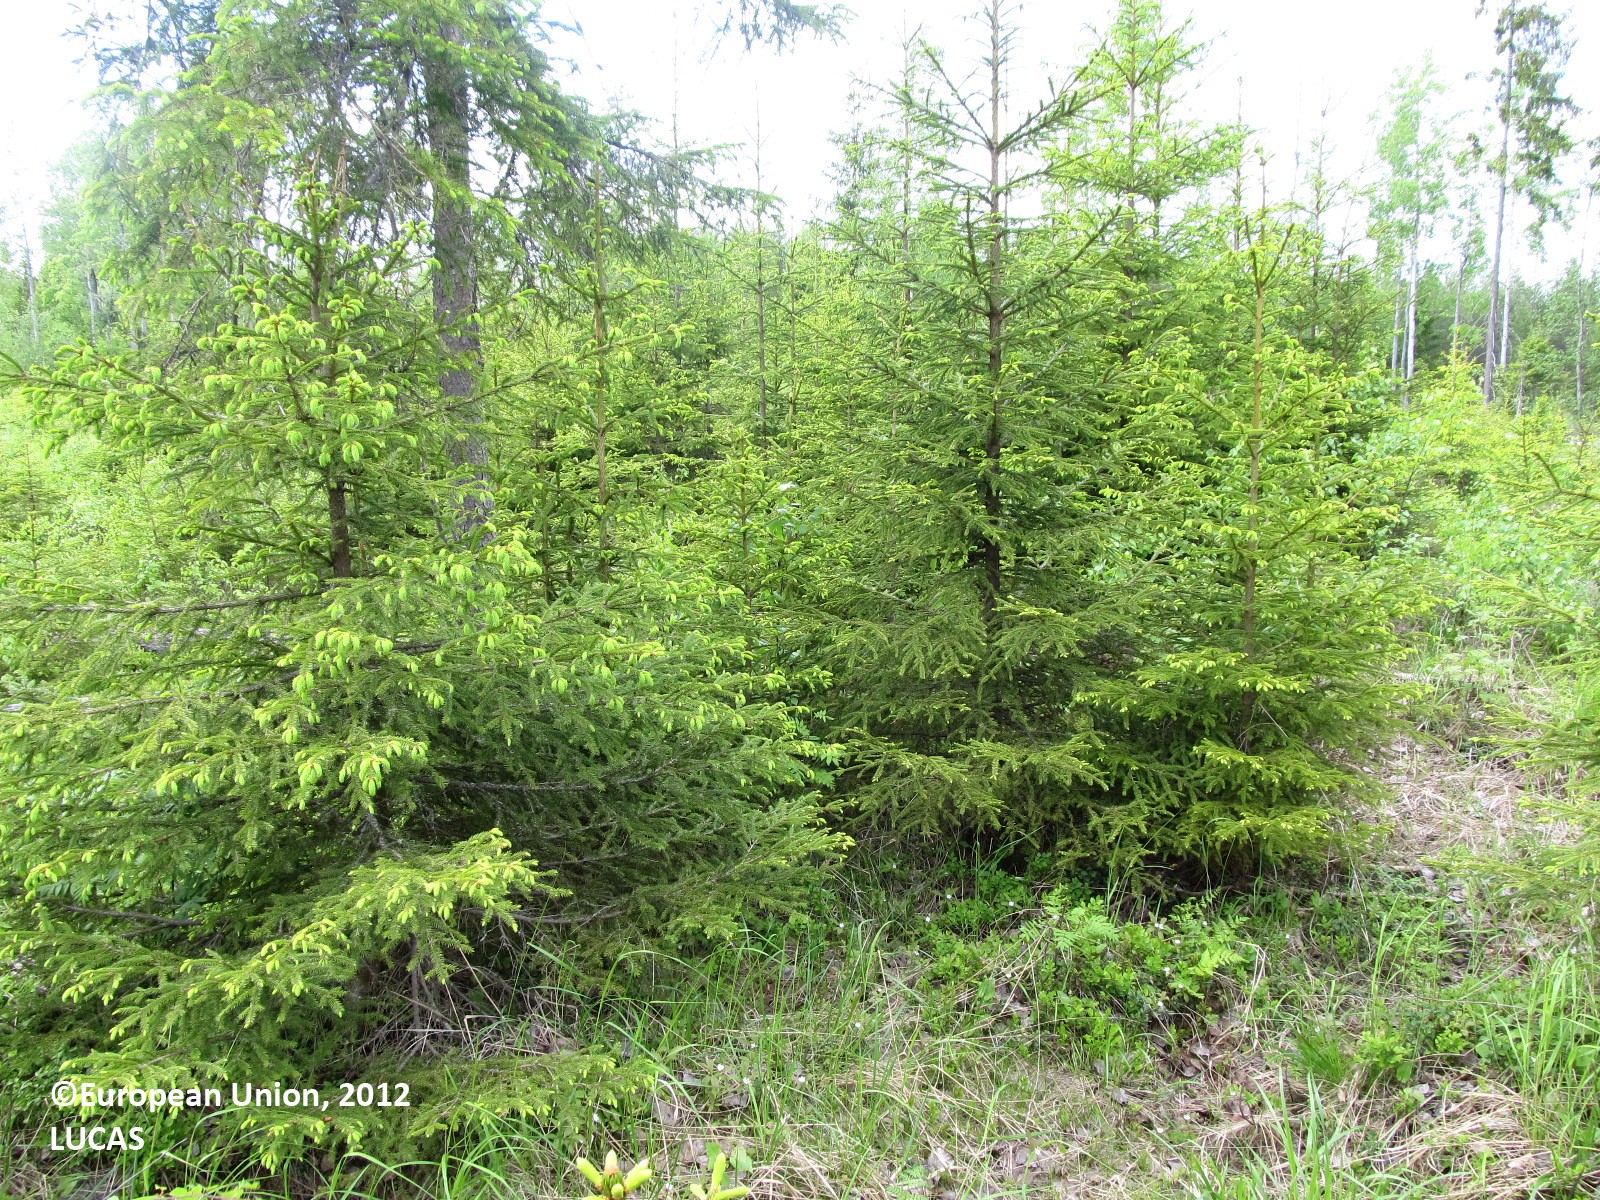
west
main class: Woodland
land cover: Spruce dominated coniferous woodland
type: boreal forest
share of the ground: 25 - 50 %
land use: Forestry
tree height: < 5 m
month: June
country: FI
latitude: 62.5795
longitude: 28.8402
